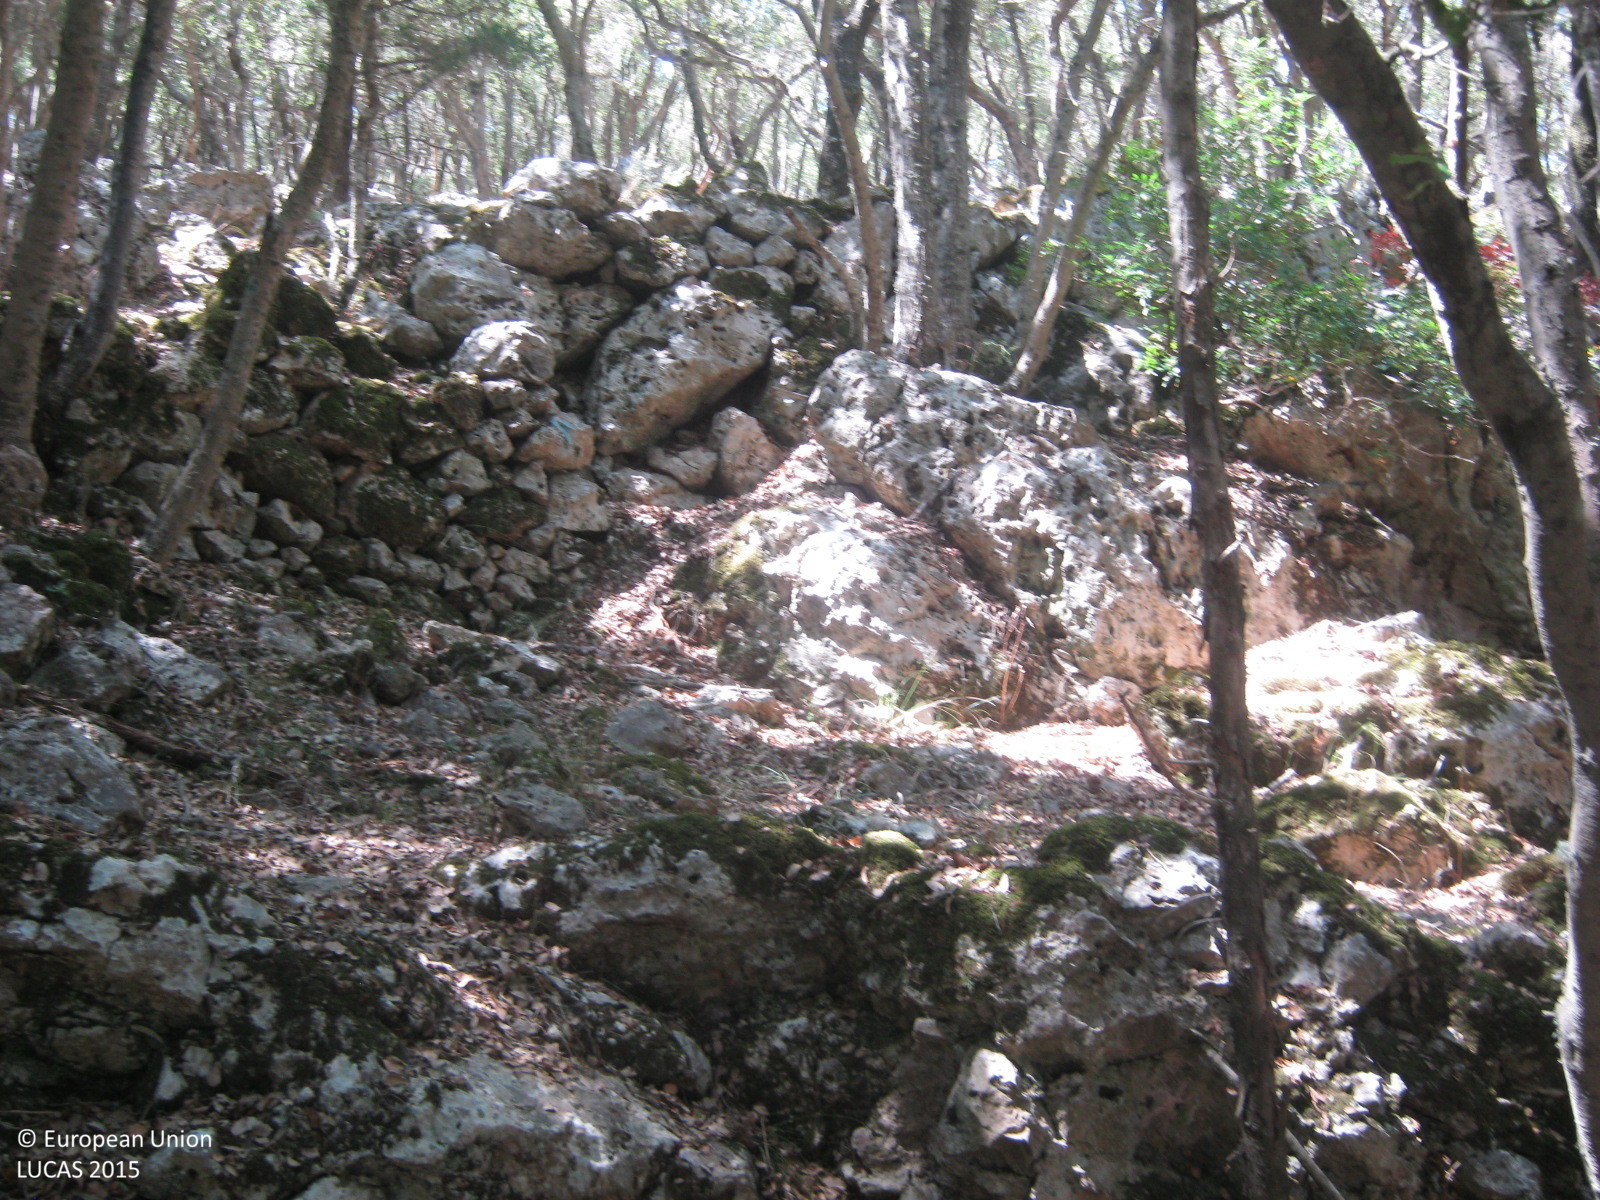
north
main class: Woodland
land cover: Broadleaved woodland
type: thermophilous deciduous forest
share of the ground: > 75 %
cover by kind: broadleaved forest trees 90 %, shrubs 5 %, consolidated bare surface 5 %
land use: Semi-natural and natural areas not in use
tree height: > 5 m
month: July
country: GR
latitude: 38.4187
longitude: 20.5581
